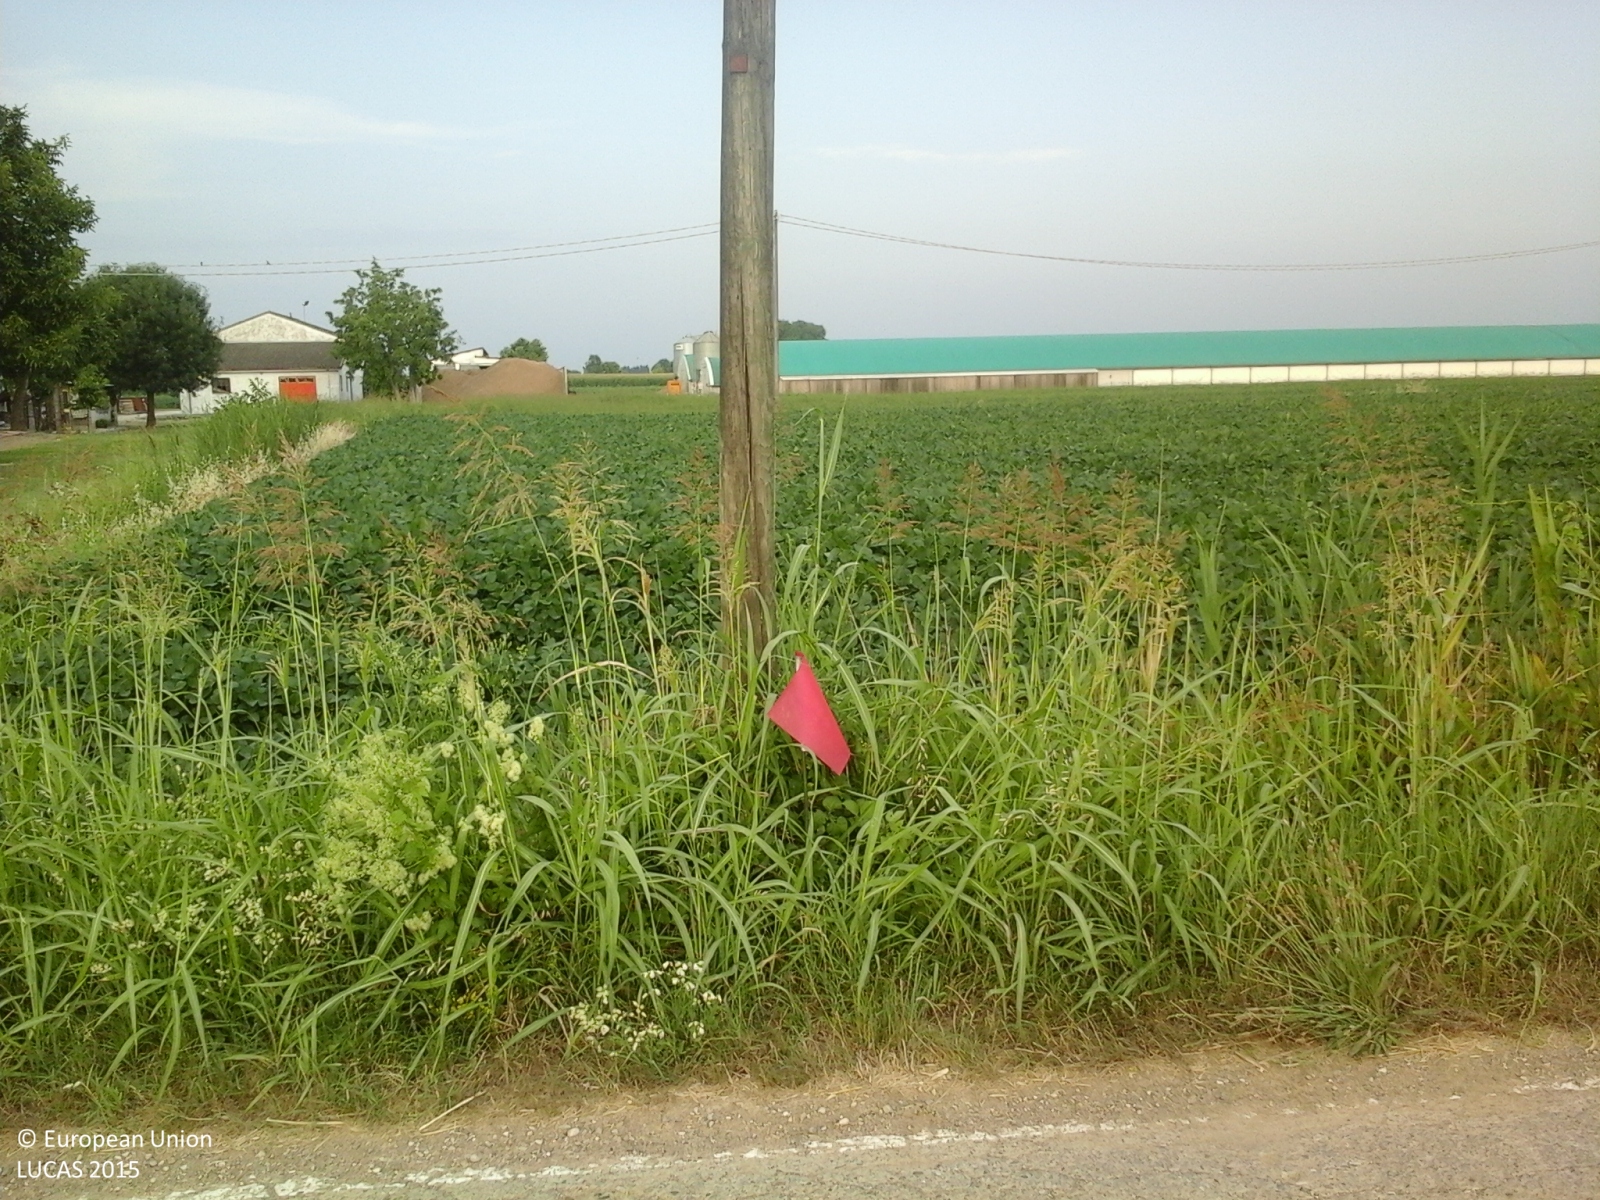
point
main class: Cropland
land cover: Soya
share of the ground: > 75 %
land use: Agriculture (excluding fallow land and kitchen gardens)
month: July
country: IT
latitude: 45.2484
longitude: 10.8775
